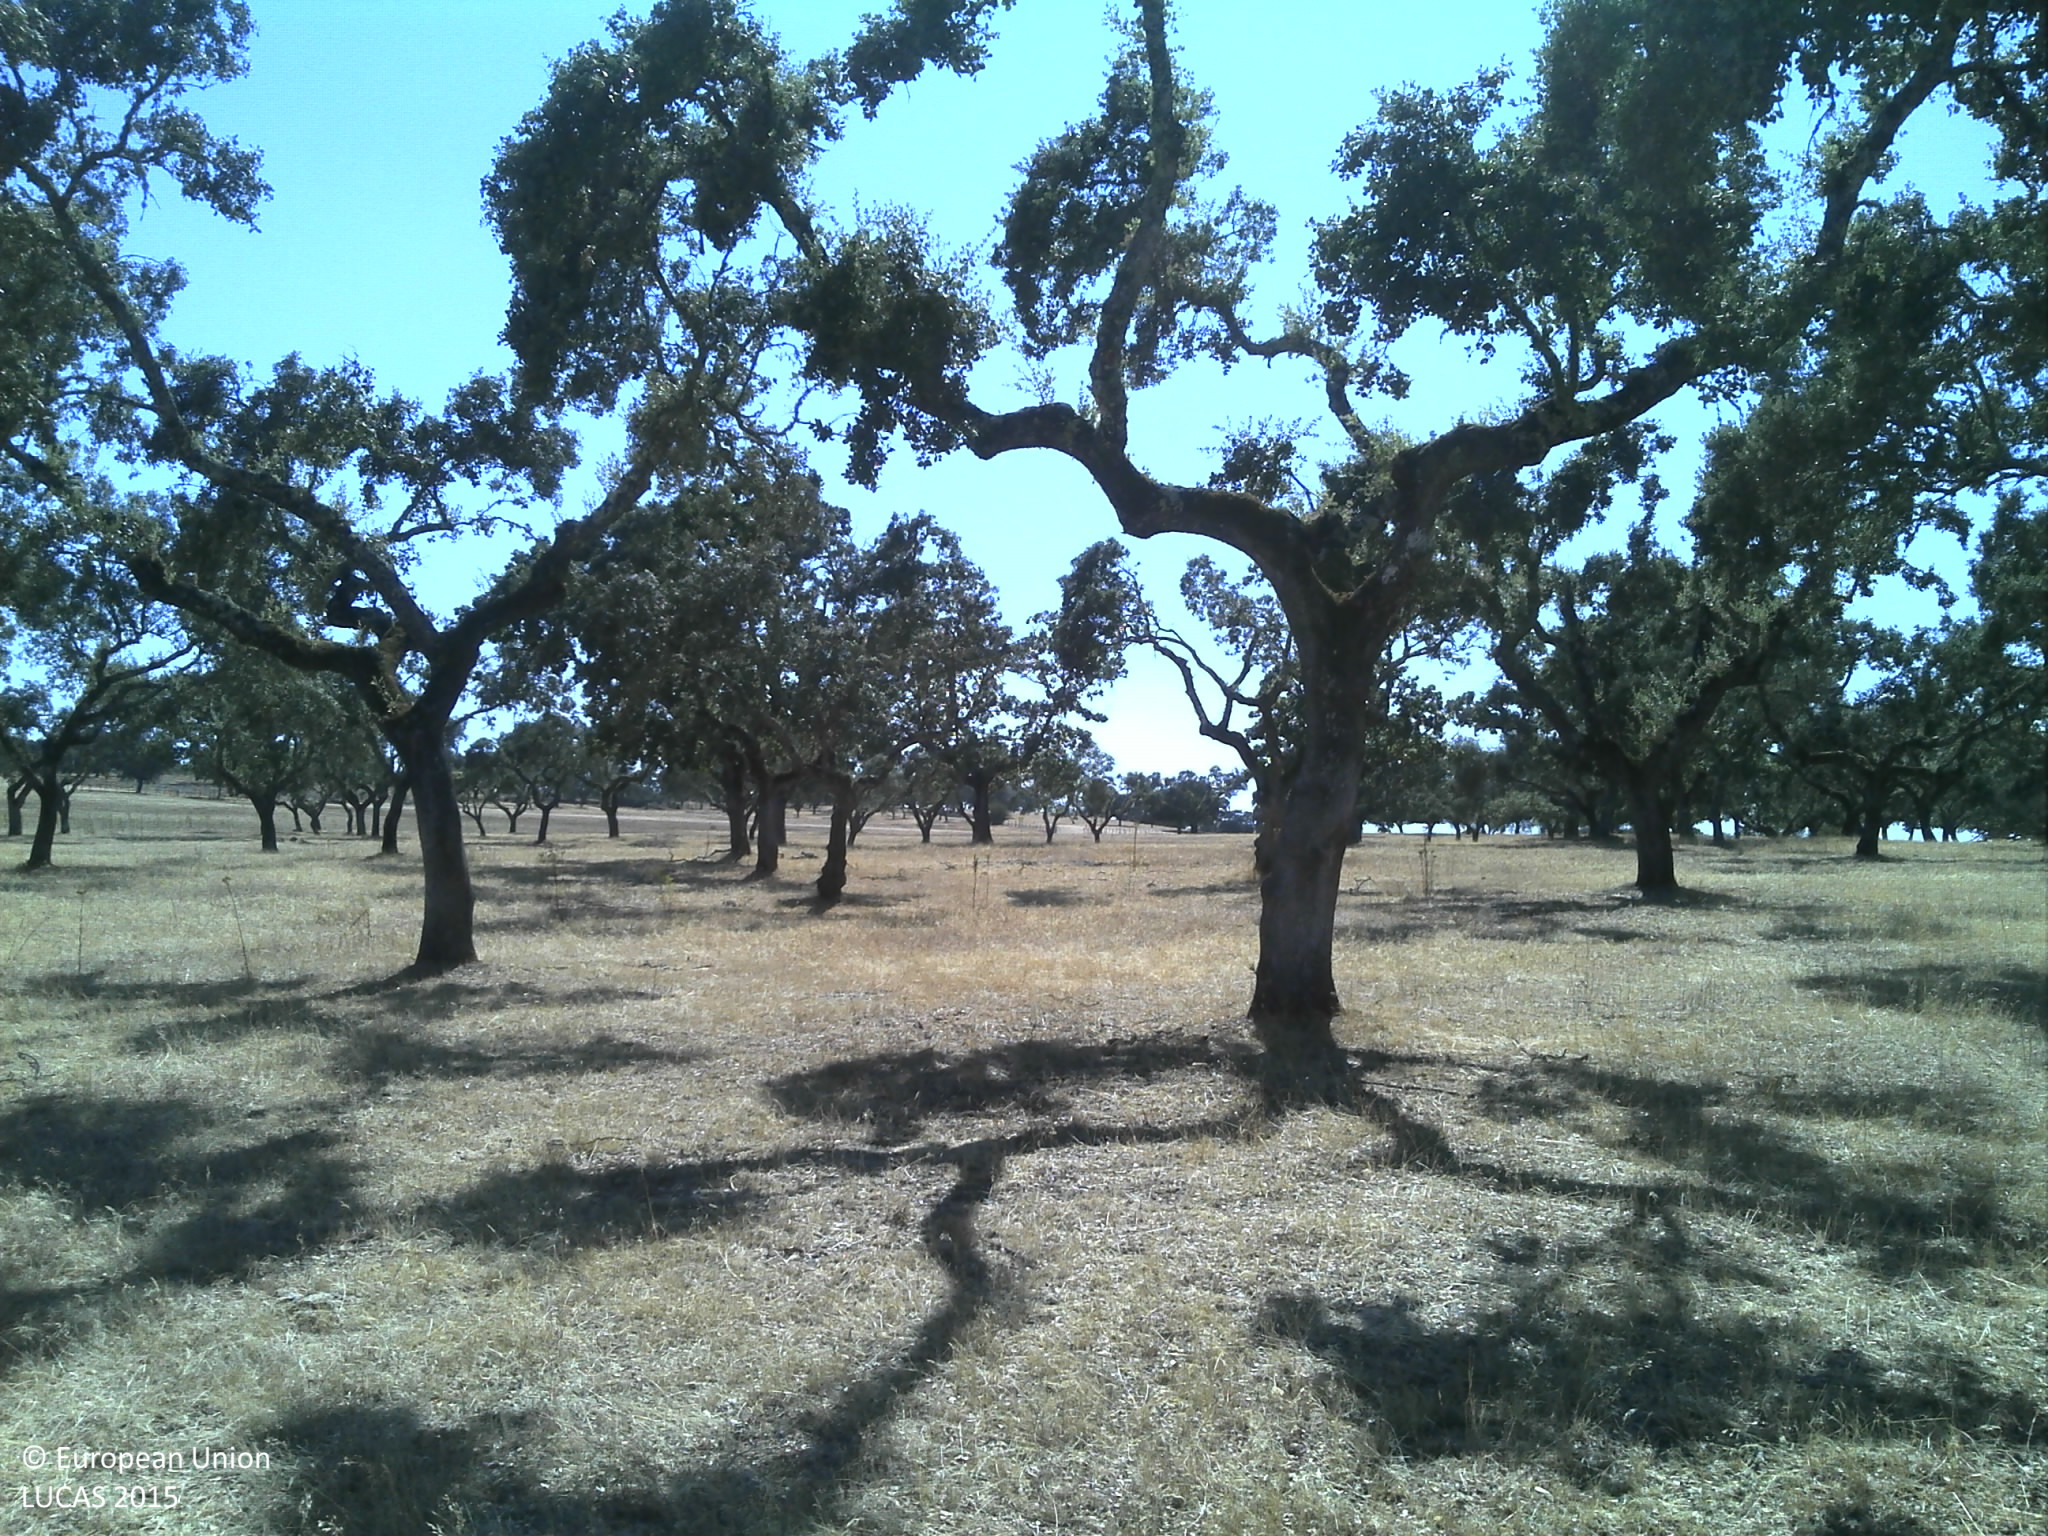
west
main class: Woodland
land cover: Broadleaved woodland
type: broadleaved evergreen forest
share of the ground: 25 - 50 %
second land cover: Grassland without tree/shrub cover
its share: 10 - 25 %
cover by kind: unconsolidated bare surface 50 %, broadleaved forest trees 30 %, herbaceous plants 20 %
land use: Forestry
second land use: Agriculture (excluding fallow land and kitchen gardens)
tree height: > 5 m
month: July
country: PT
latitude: 39.3408
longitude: -7.6248
